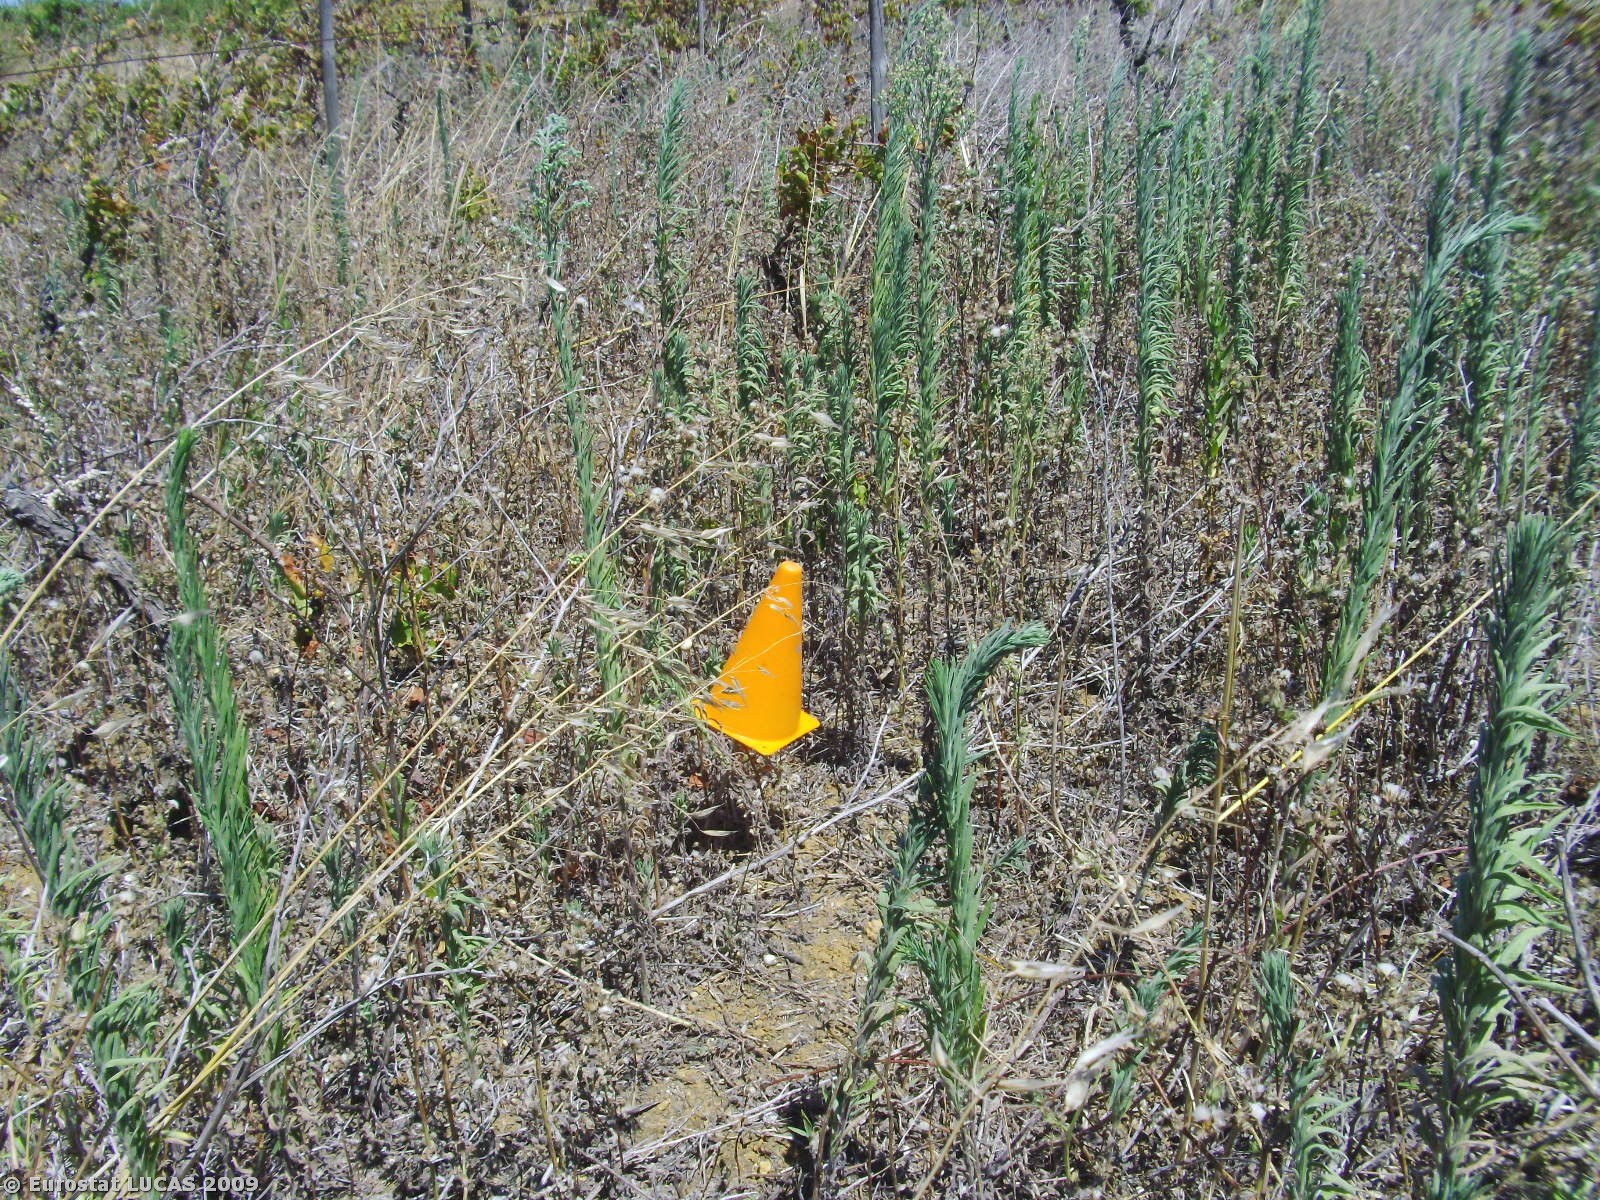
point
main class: Cropland
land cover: Vineyards
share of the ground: 25 - 50 %
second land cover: Spontaneously vegetated surfaces
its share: 25 - 50 %
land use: Fallow land
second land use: Unused
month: July
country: PT
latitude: 39.1254
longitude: -8.8485
